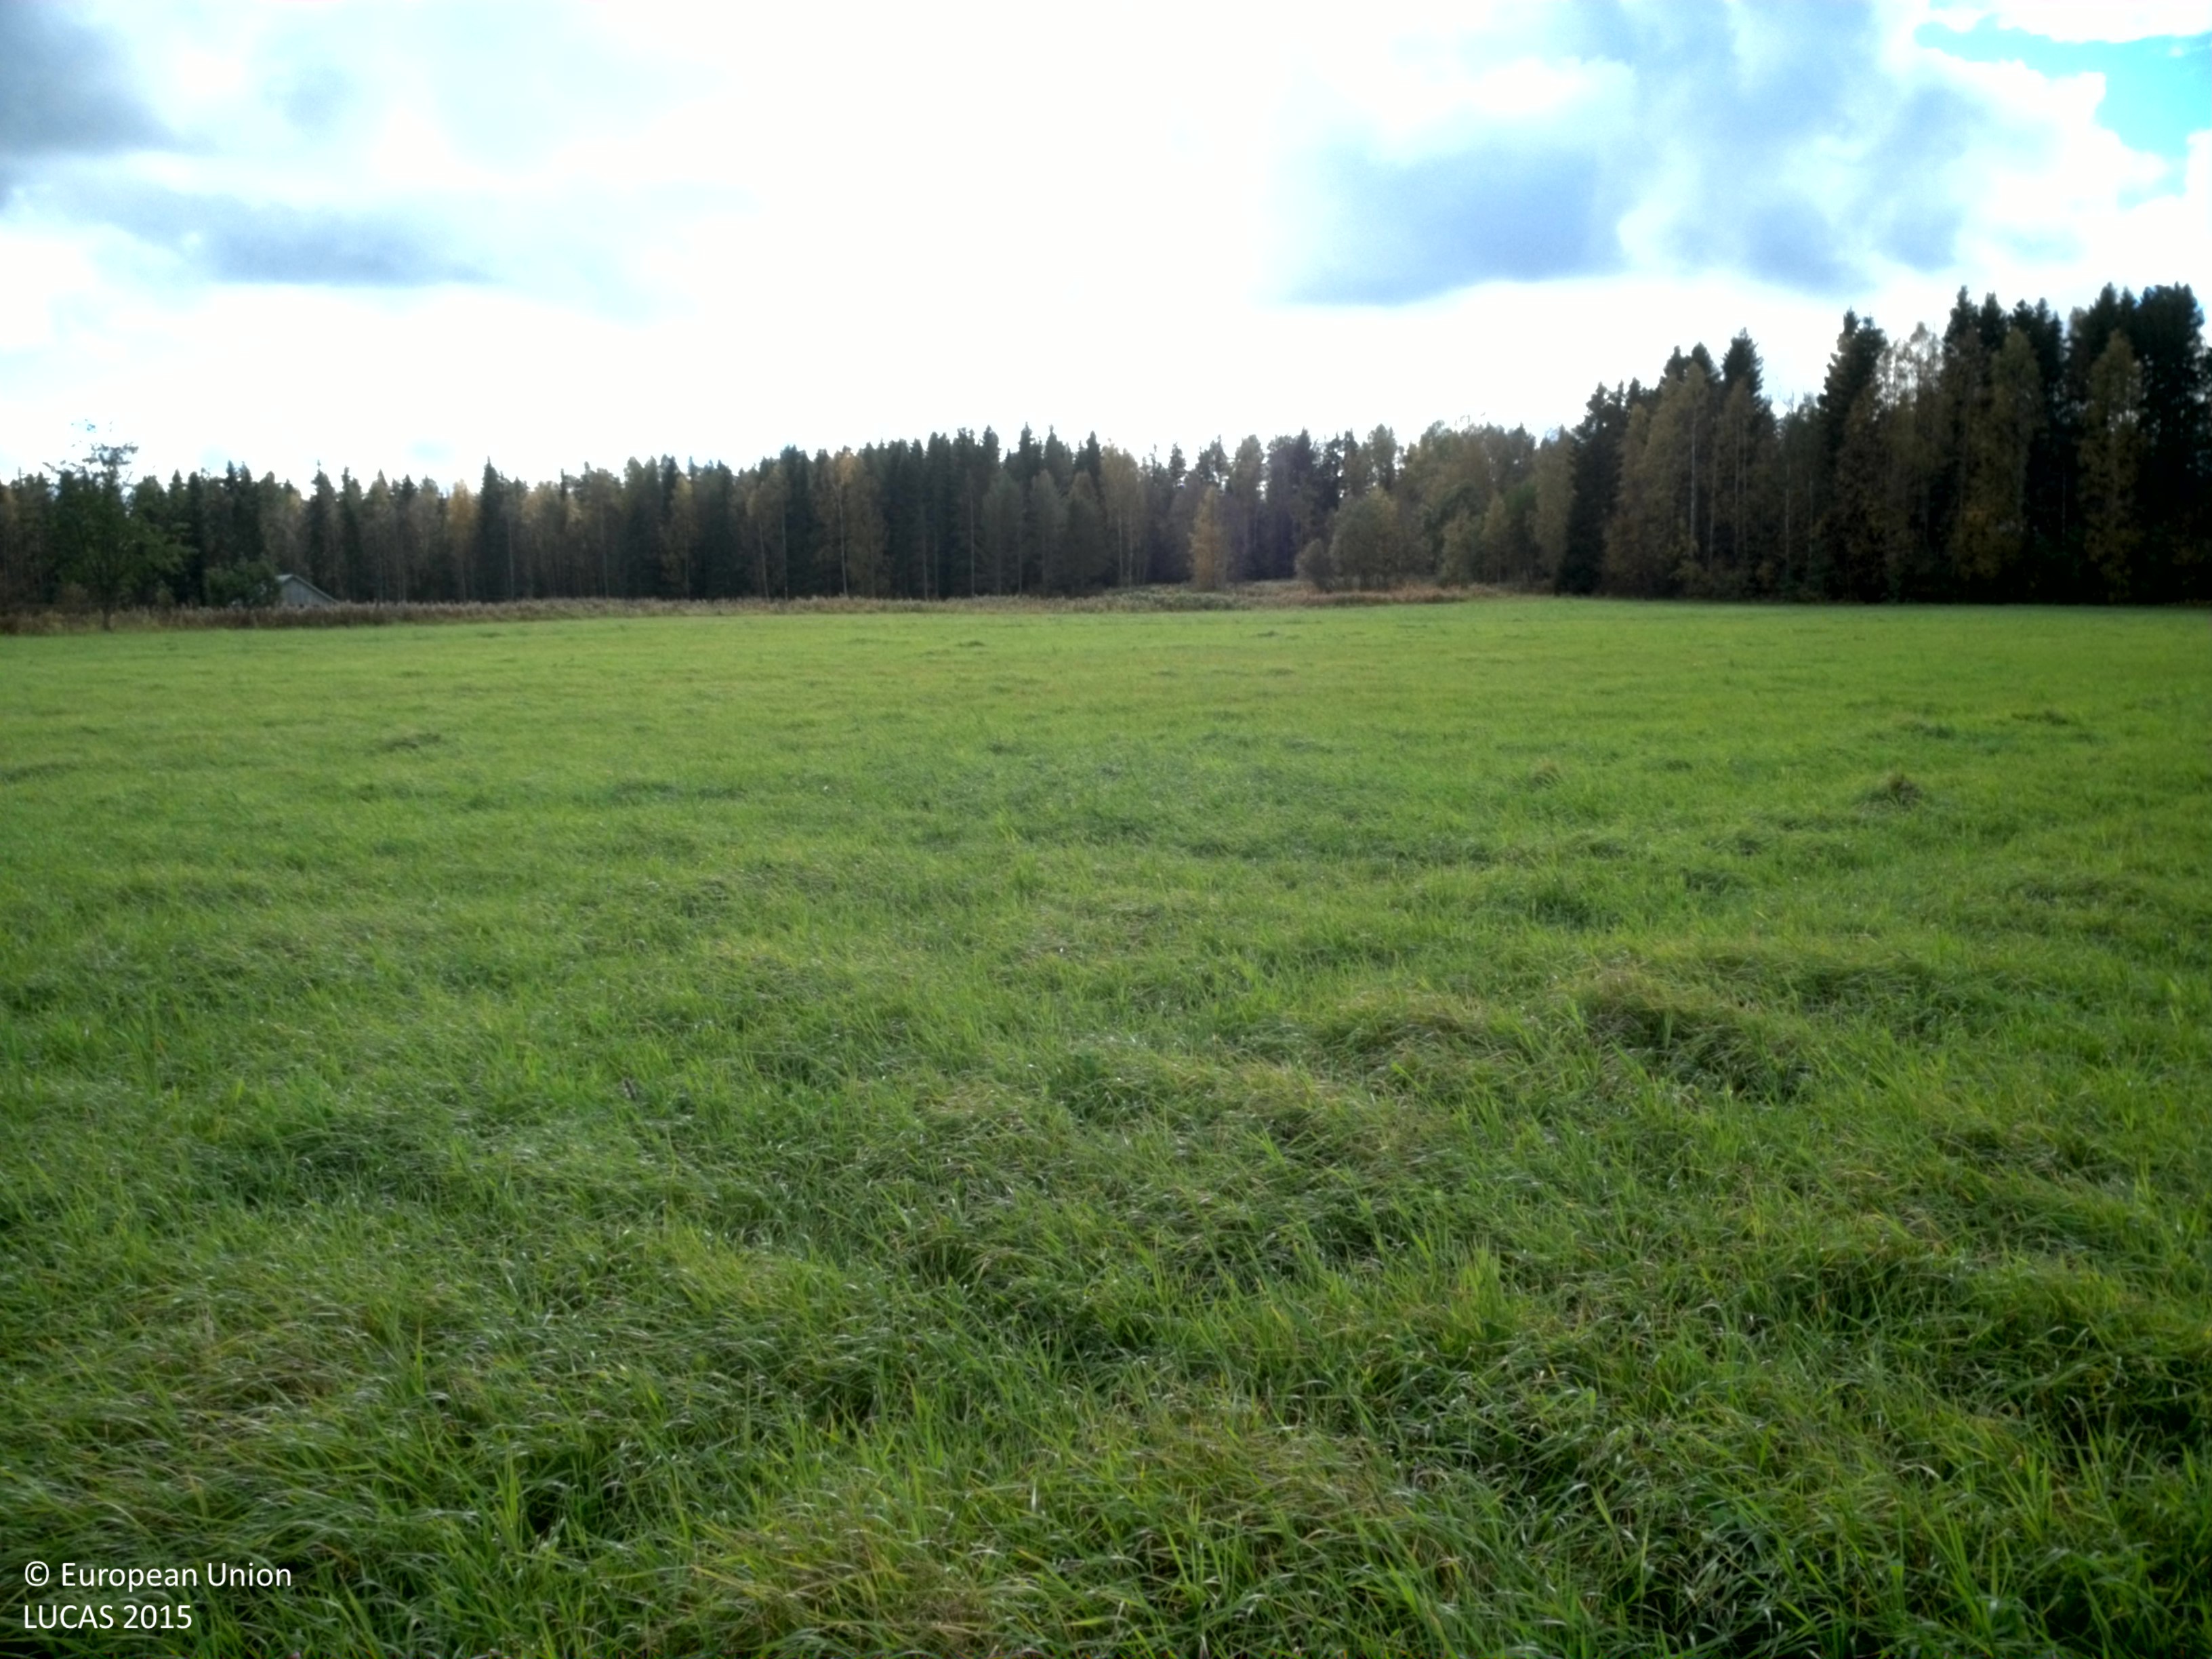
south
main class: Cropland
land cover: Temporary grasslands
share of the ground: > 75 %
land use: Agriculture (excluding fallow land and kitchen gardens)
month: September
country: SE
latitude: 65.7009
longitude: 22.2405
